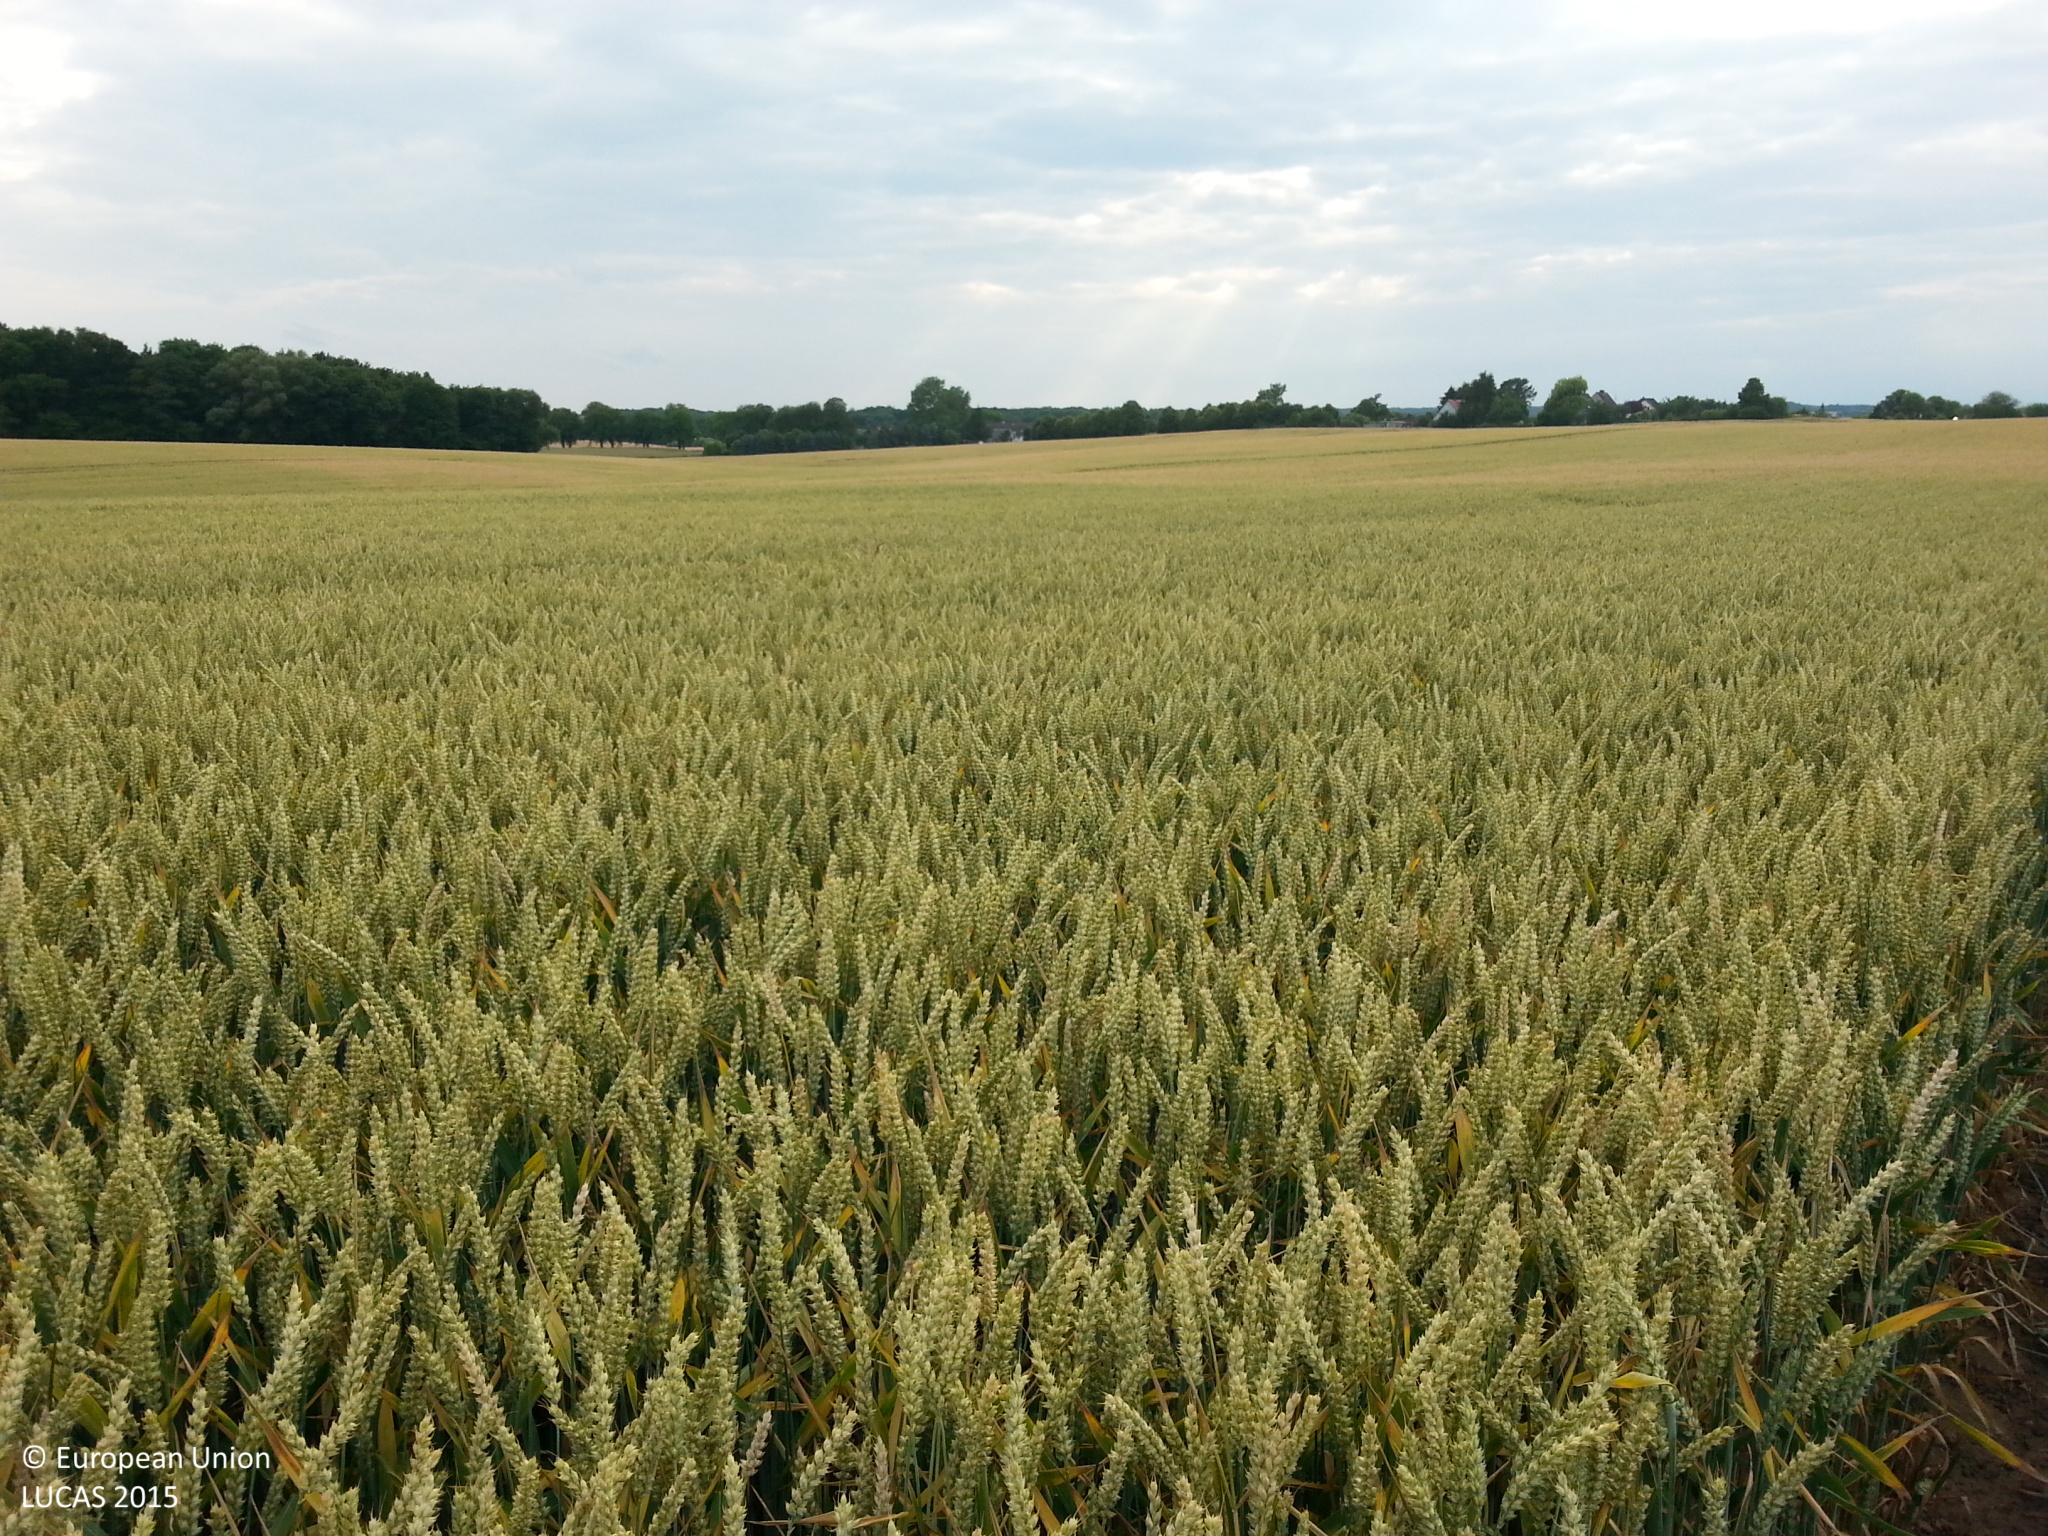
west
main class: Cropland
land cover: Common wheat
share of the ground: > 75 %
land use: Agriculture (excluding fallow land and kitchen gardens)
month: July
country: DE
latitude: 53.9534
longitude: 11.1728
